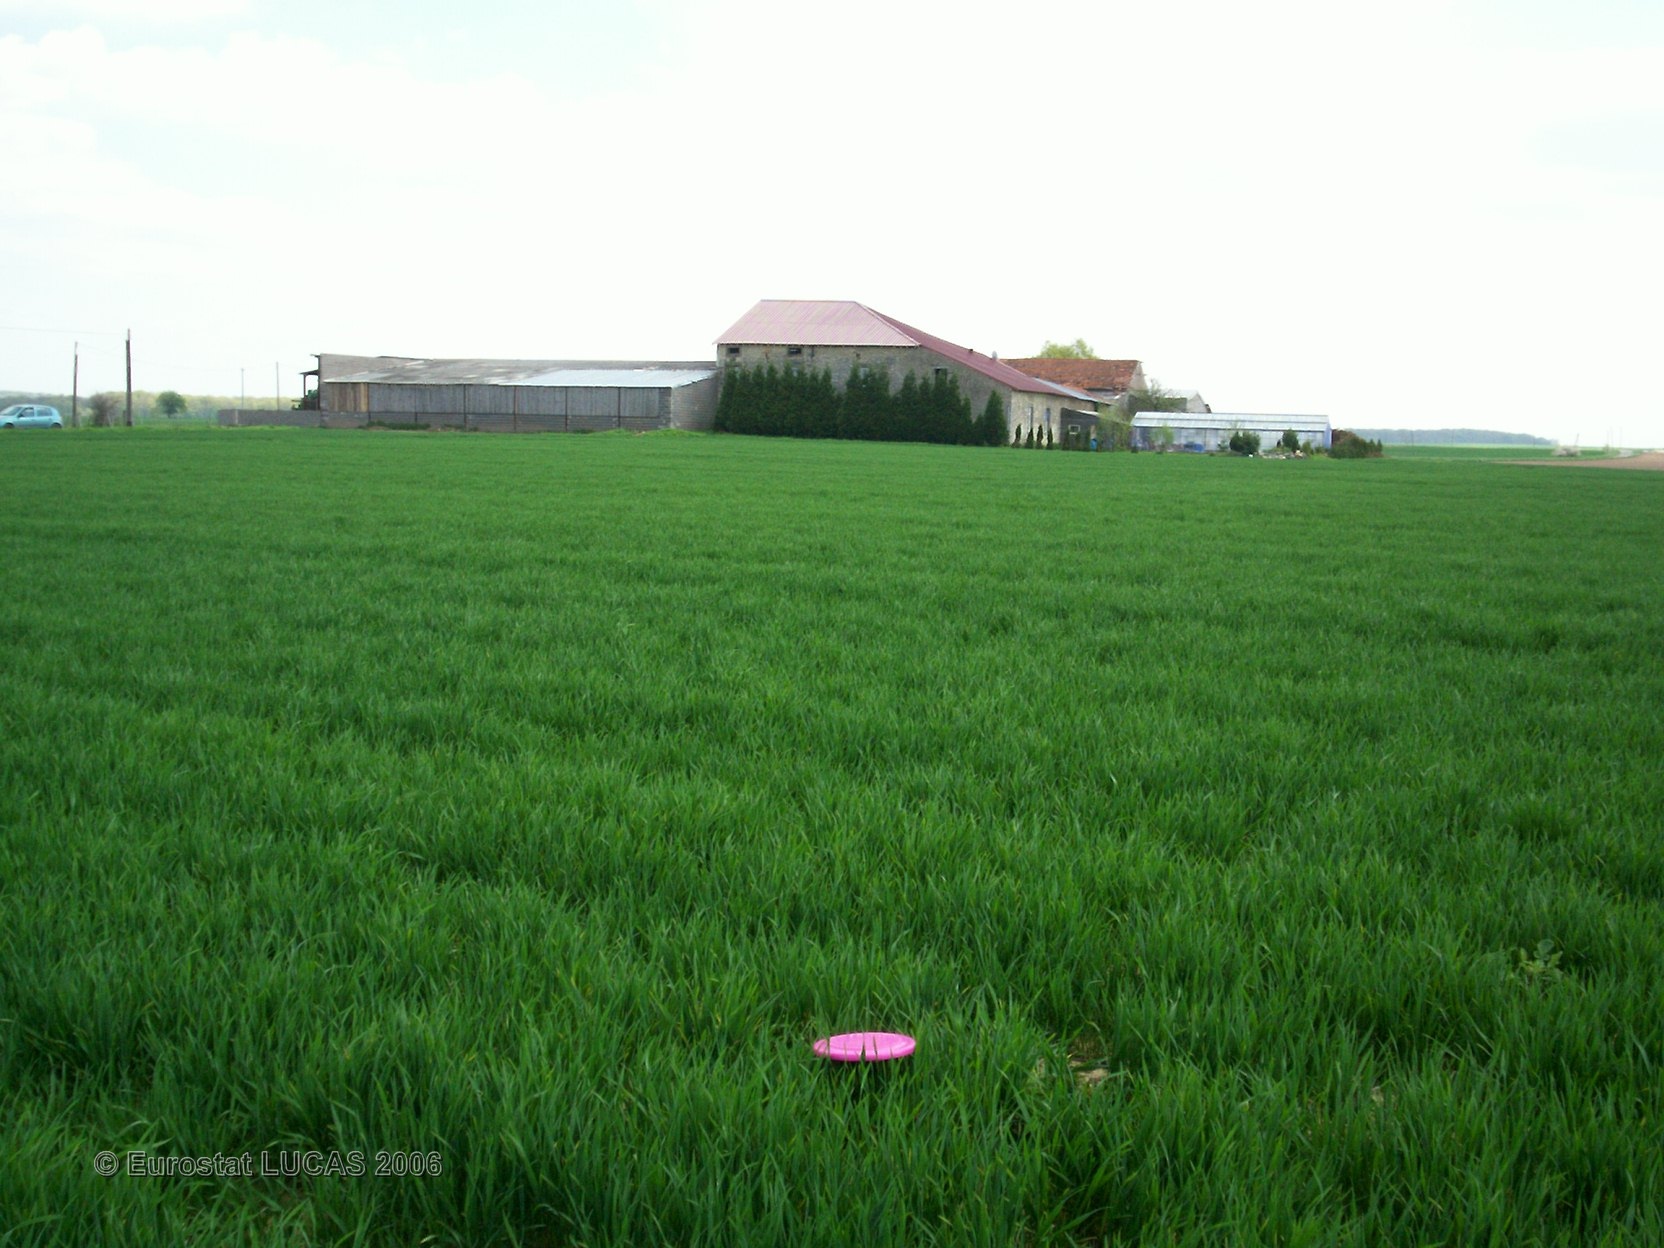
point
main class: Cropland
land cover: Common wheat
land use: Agriculture (excluding fallow land and kitchen gardens)
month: April
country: FR
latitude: 49.0035
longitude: 6.7332
